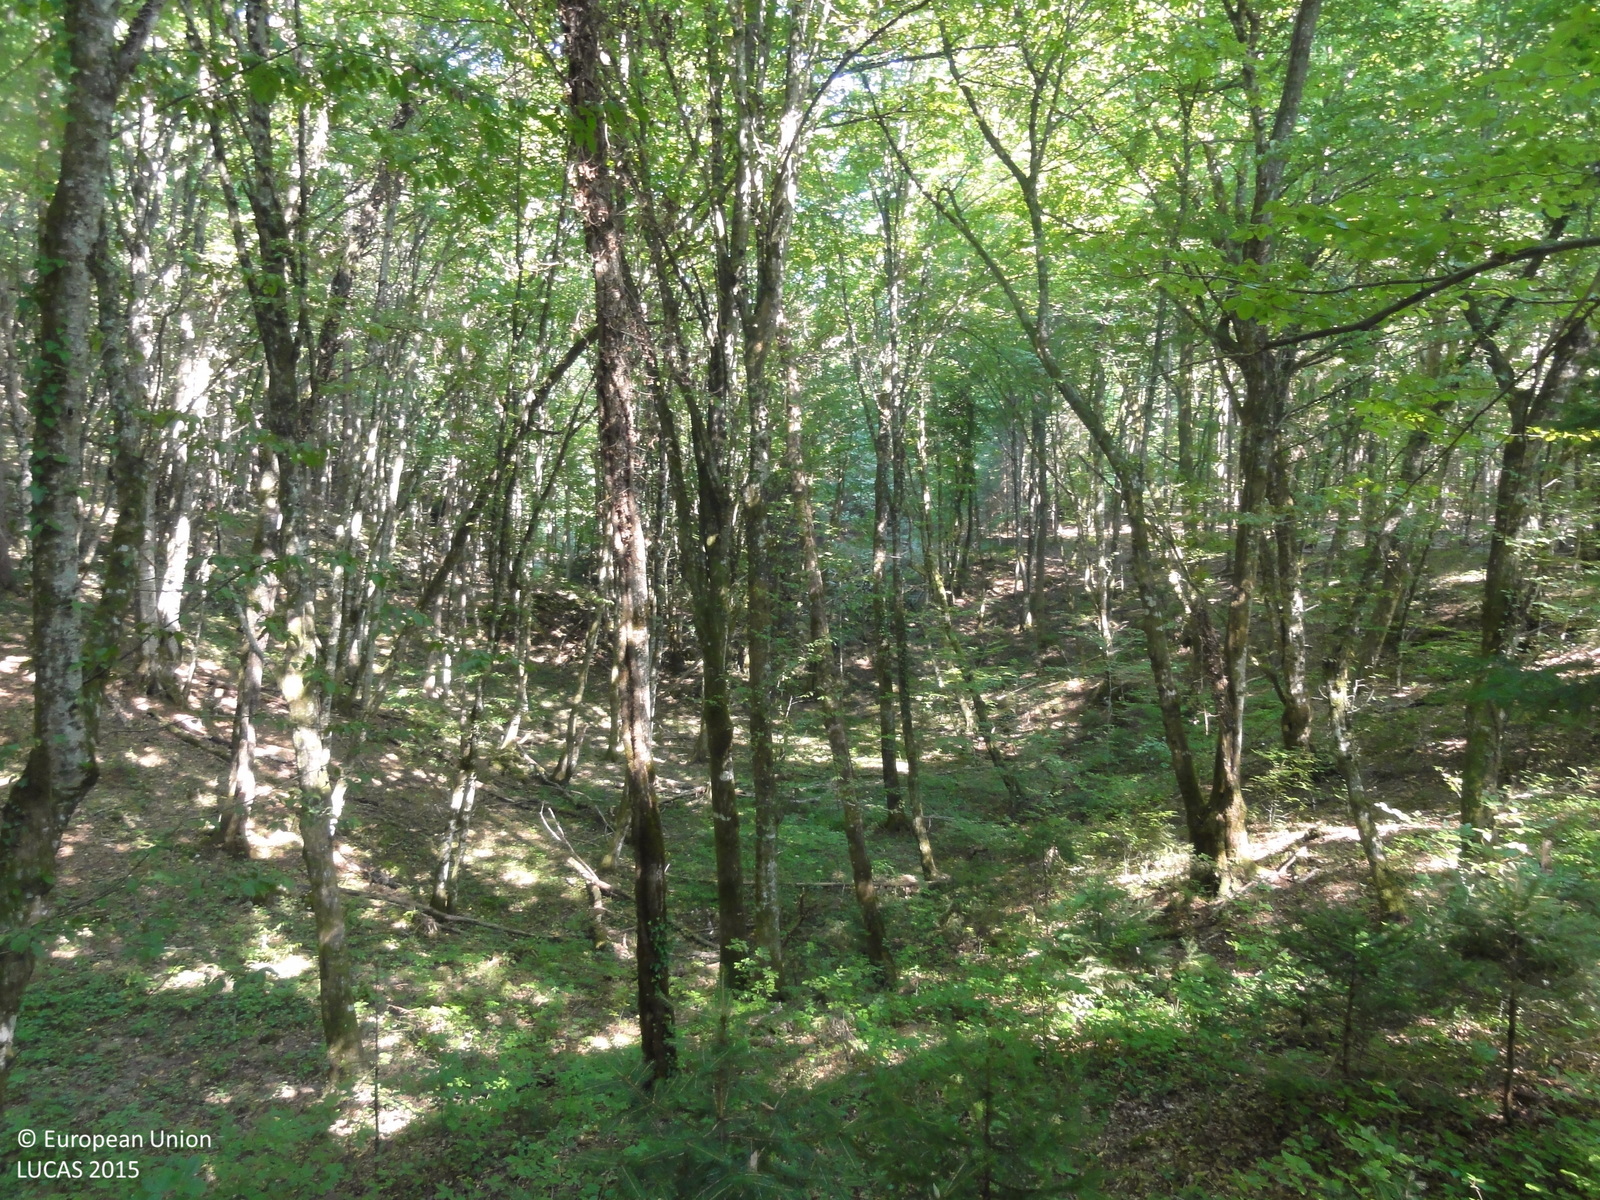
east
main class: Woodland
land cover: Broadleaved woodland
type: beech forest
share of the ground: > 75 %
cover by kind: broadleaved forest trees 85 %, coniferous forest trees 15 %
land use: Forestry
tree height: > 5 m
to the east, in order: Broadleaved woodland; Spruce dominated mixed woodland
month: August
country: SI
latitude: 45.8346
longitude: 15.0560
